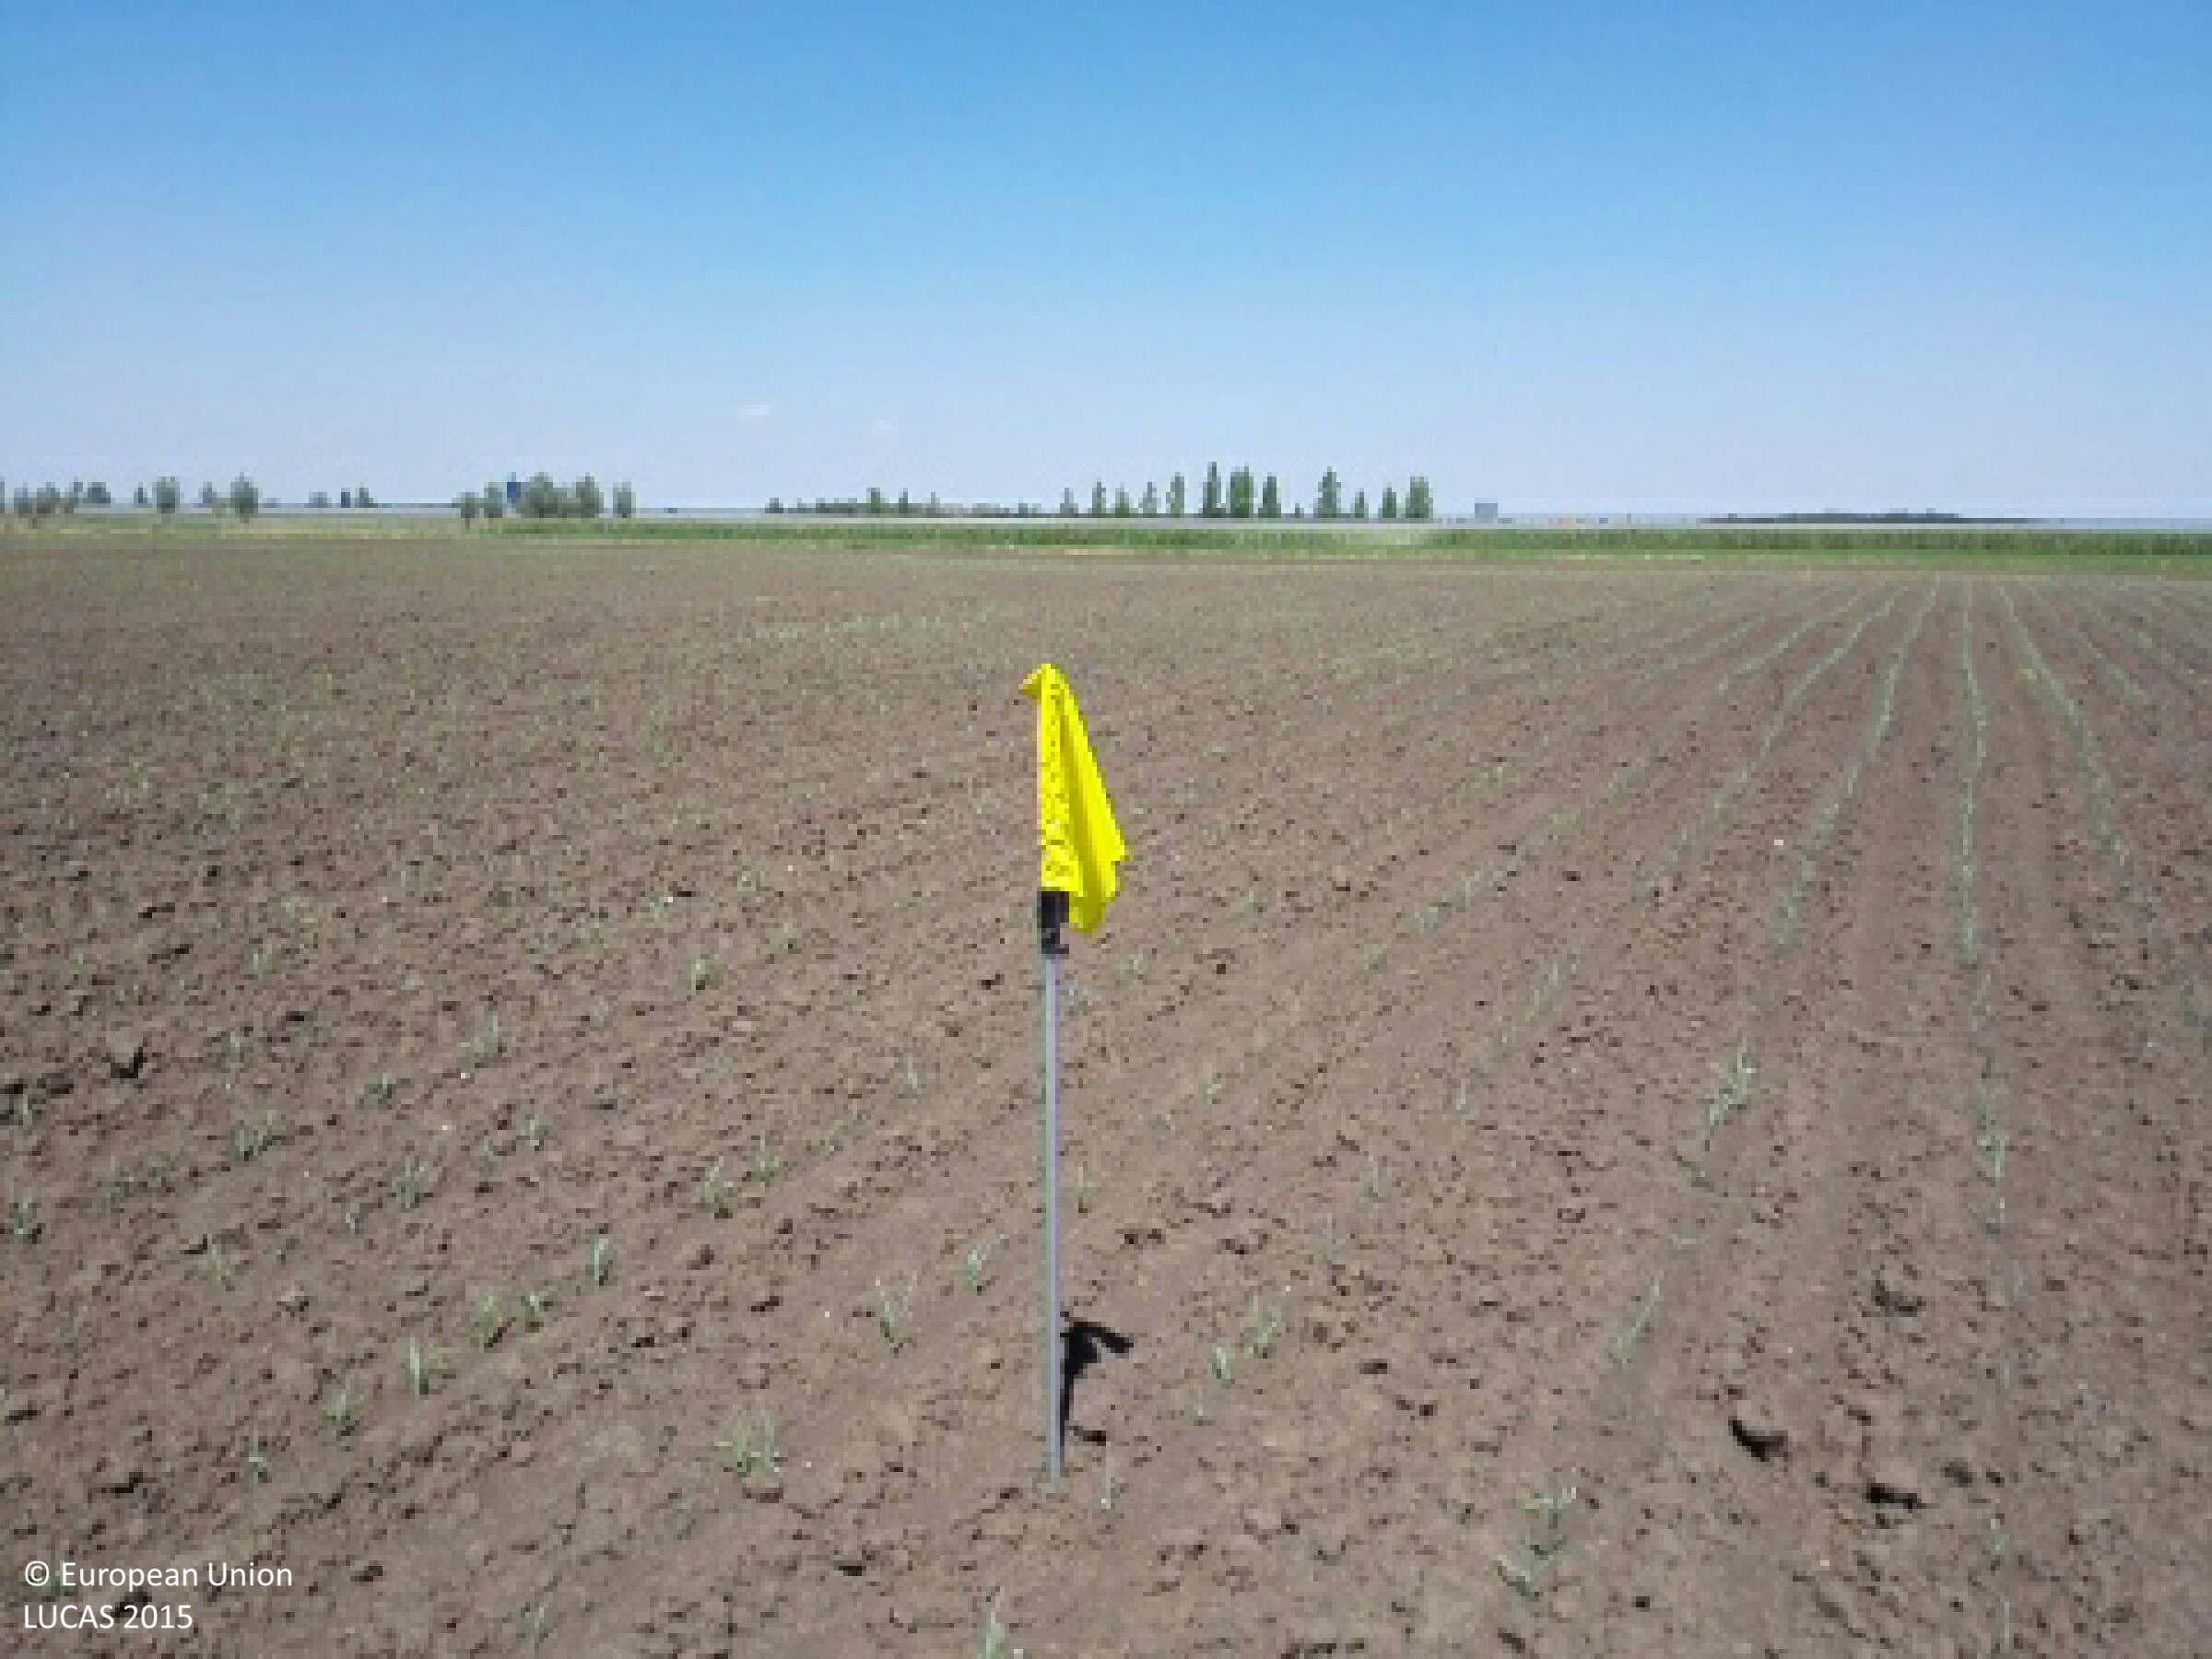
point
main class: Cropland
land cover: Maize
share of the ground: < 10 %
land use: Agriculture (excluding fallow land and kitchen gardens)
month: July
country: HU
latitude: 47.7195
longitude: 21.4138
